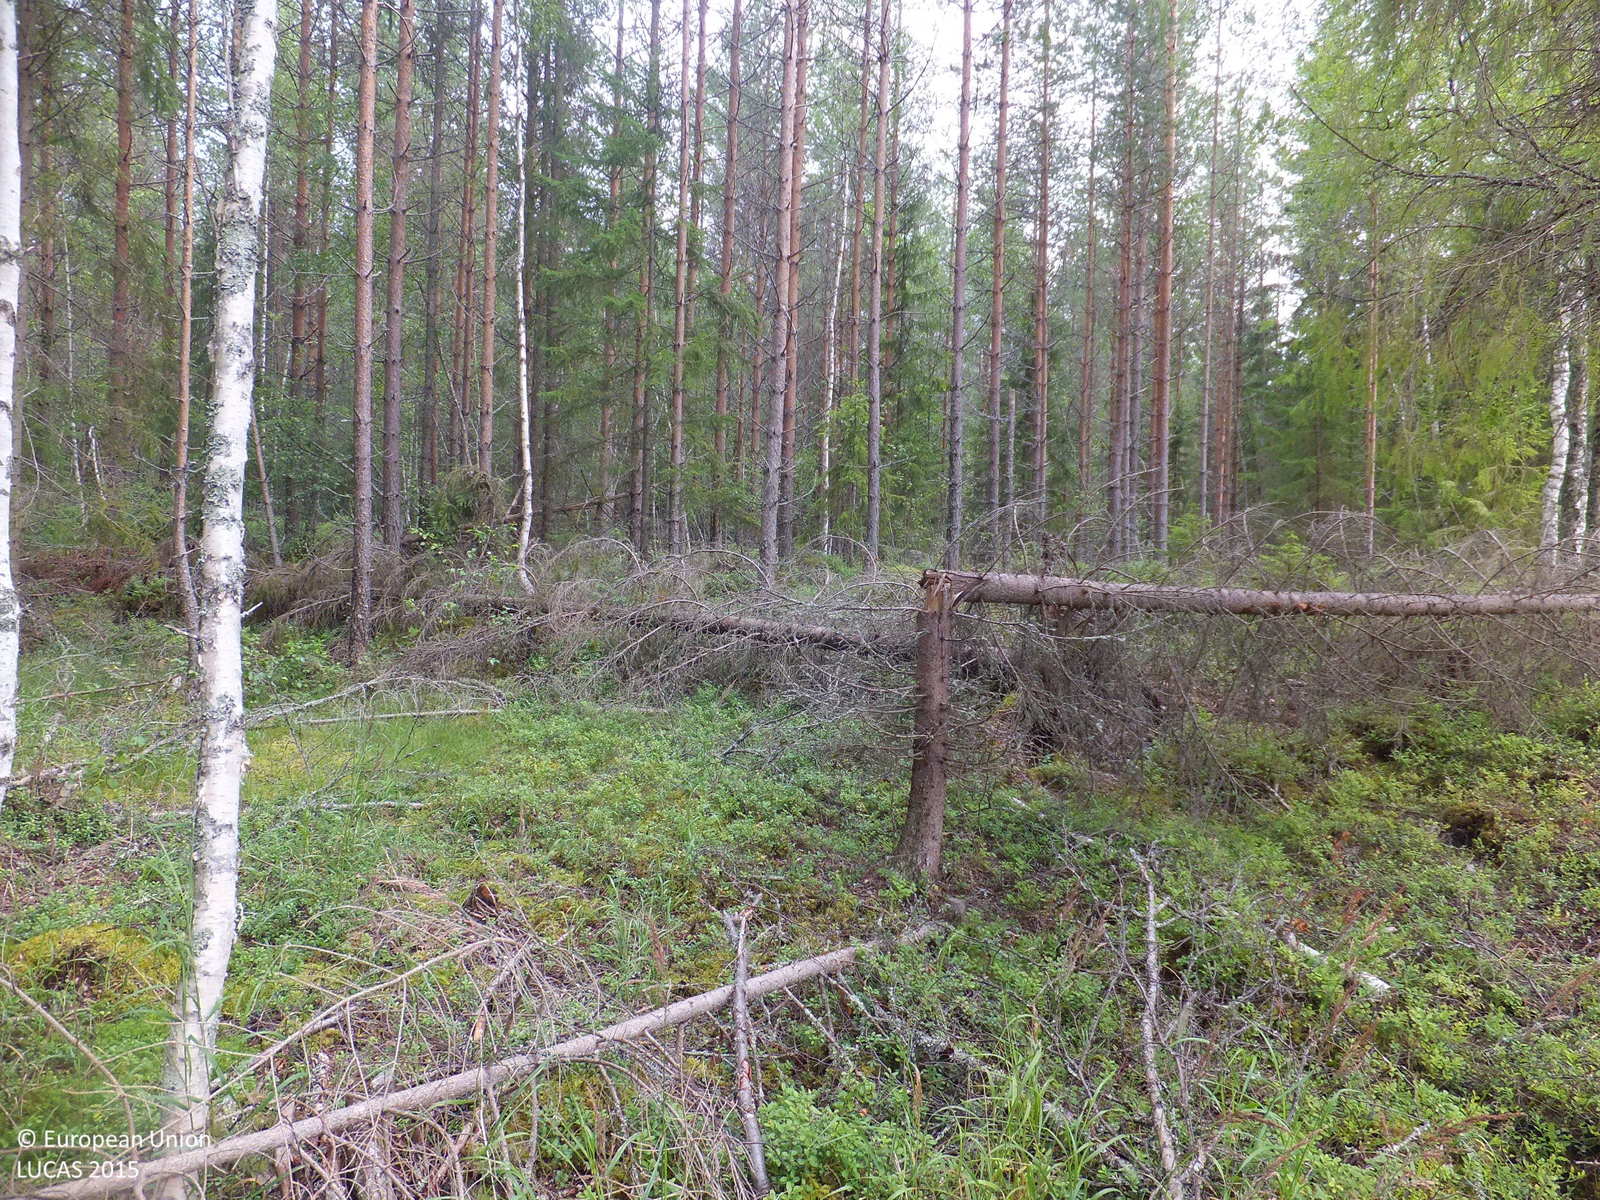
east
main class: Woodland
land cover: Other mixed woodland
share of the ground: > 75 %
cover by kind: broadleaved forest trees 50 %, coniferous forest trees 30 %, shrubs 10 %, herbaceous plants 5 %, lichens and mosses 5 %
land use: Forestry
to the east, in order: Other mixed woodland; Pine dominated mixed woodland; Tracks; Other mixed woodland; Grassland without tree/shrub cover; Electric lines; Ditches and canals; Grass margins; Paved roads, cycling and walking lanes; Grass margins; Ditches and canals; Electric lines; Other mixed woodland; Pine dominated mixed woodland
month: July
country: FI
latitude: 63.3098
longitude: 22.1170
